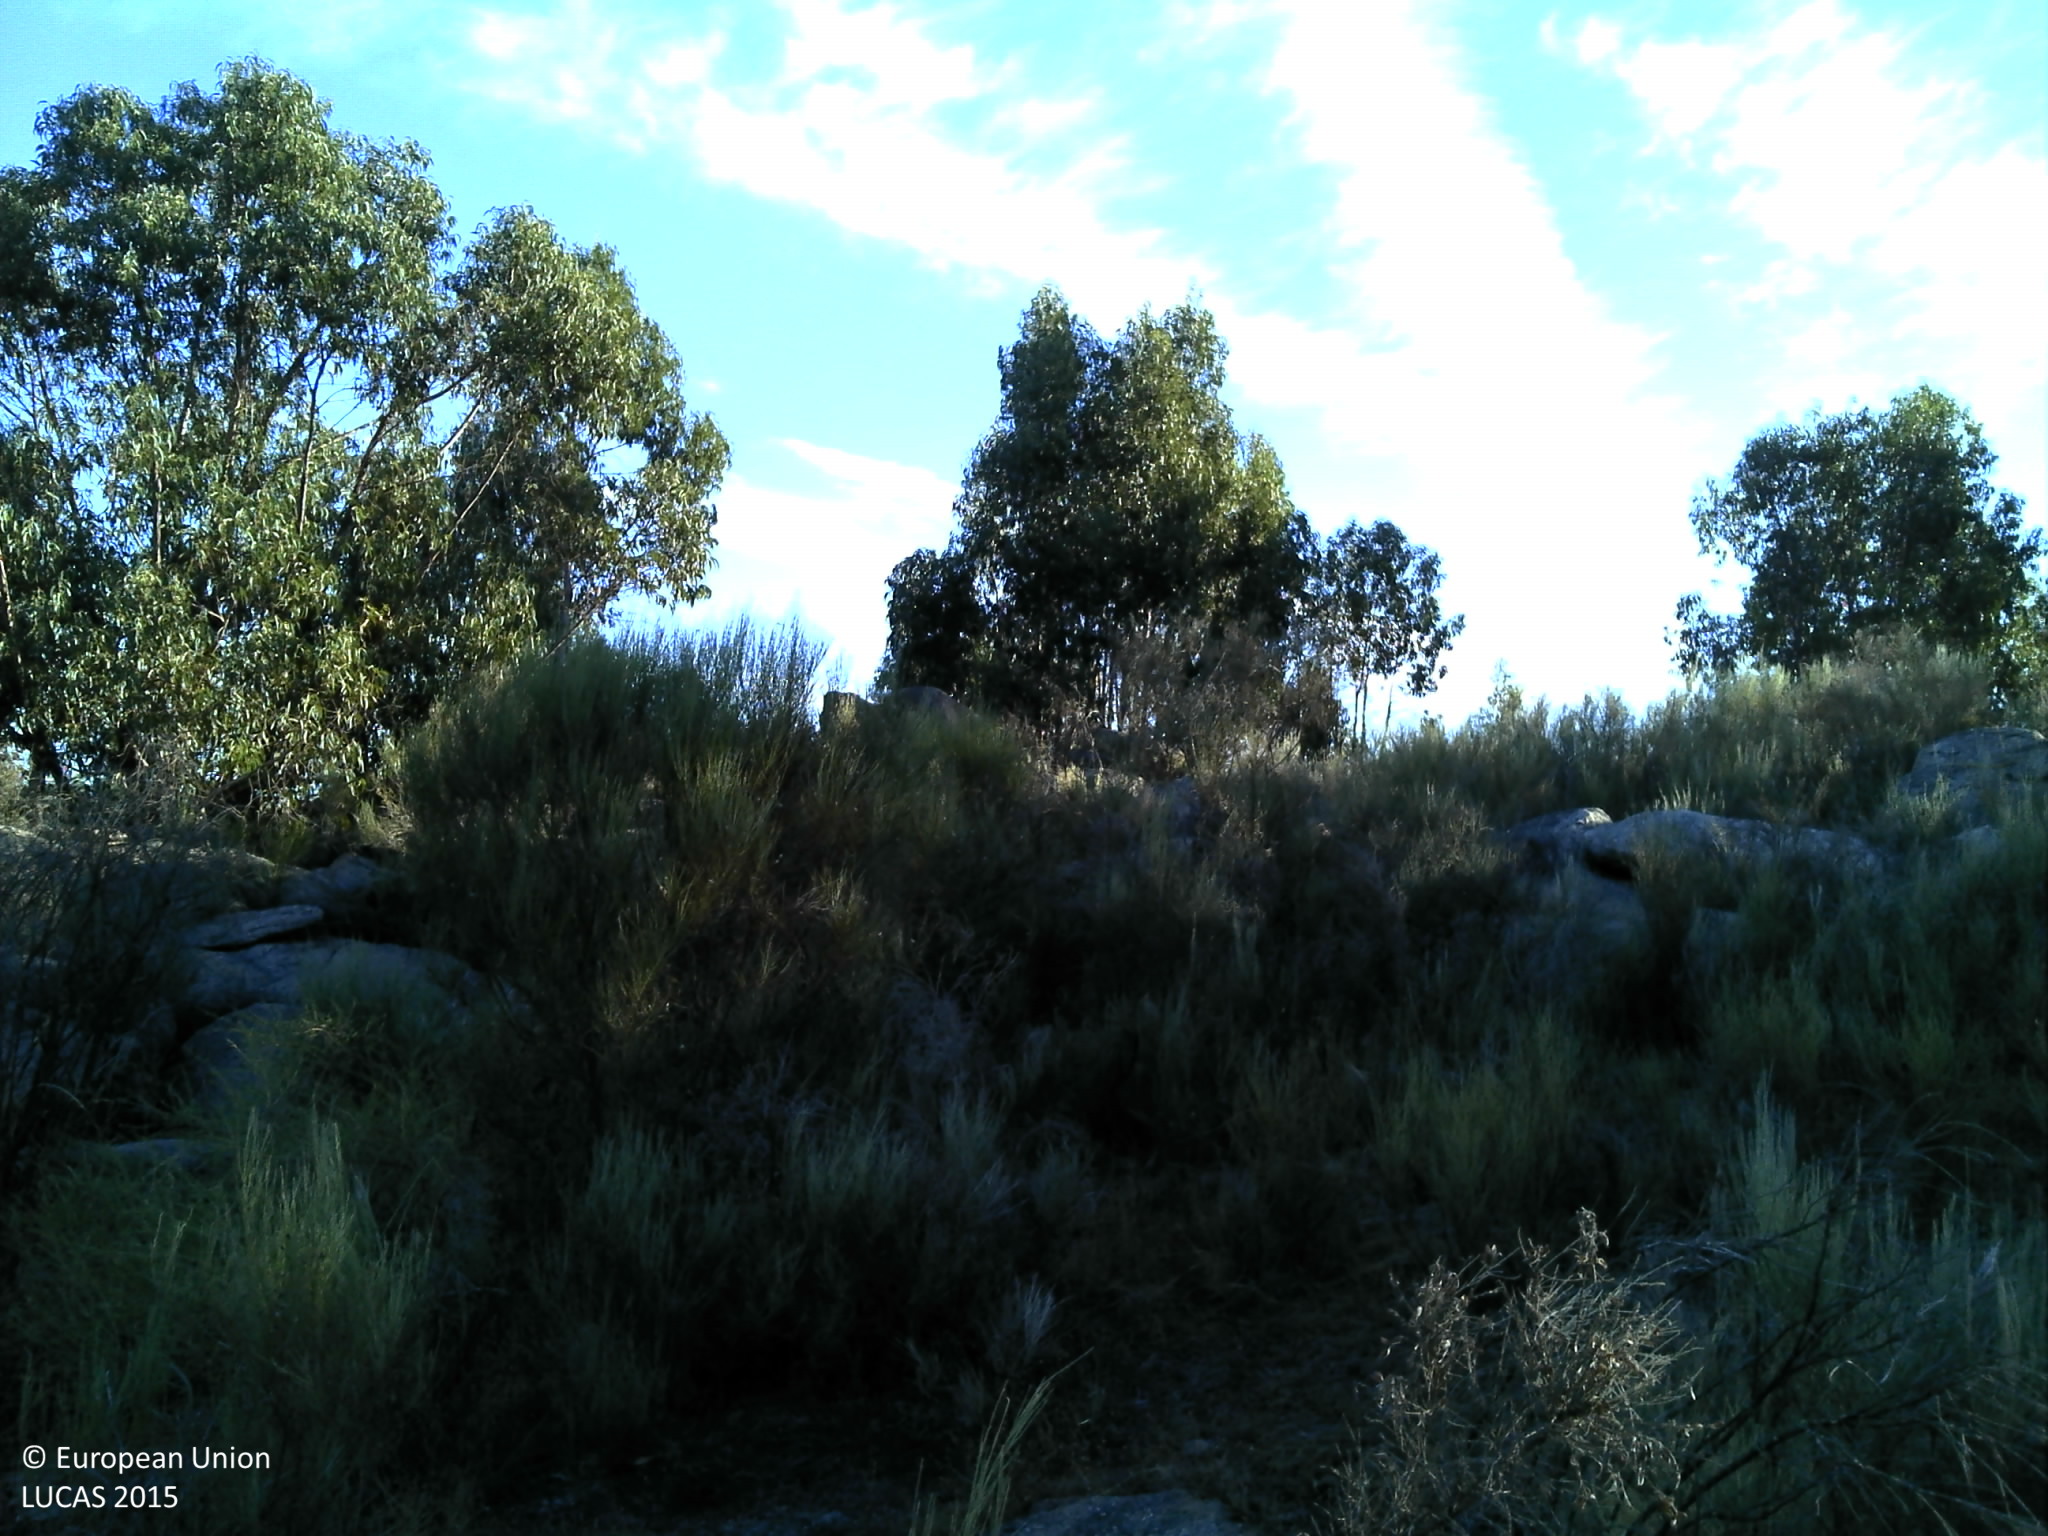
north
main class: Woodland
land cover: Broadleaved woodland
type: broadleaved evergreen forest
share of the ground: 10 - 25 %
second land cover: Shrubland without tree cover
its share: 25 - 50 %
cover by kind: shrubs 45 %, consolidated bare surface 20 %, broadleaved forest trees 15 %, herbaceous plants 15 %, unconsolidated bare surface 5 %
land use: Forestry
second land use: Agriculture (excluding fallow land and kitchen gardens)
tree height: > 5 m
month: August
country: PT
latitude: 39.4536
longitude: -7.5130
